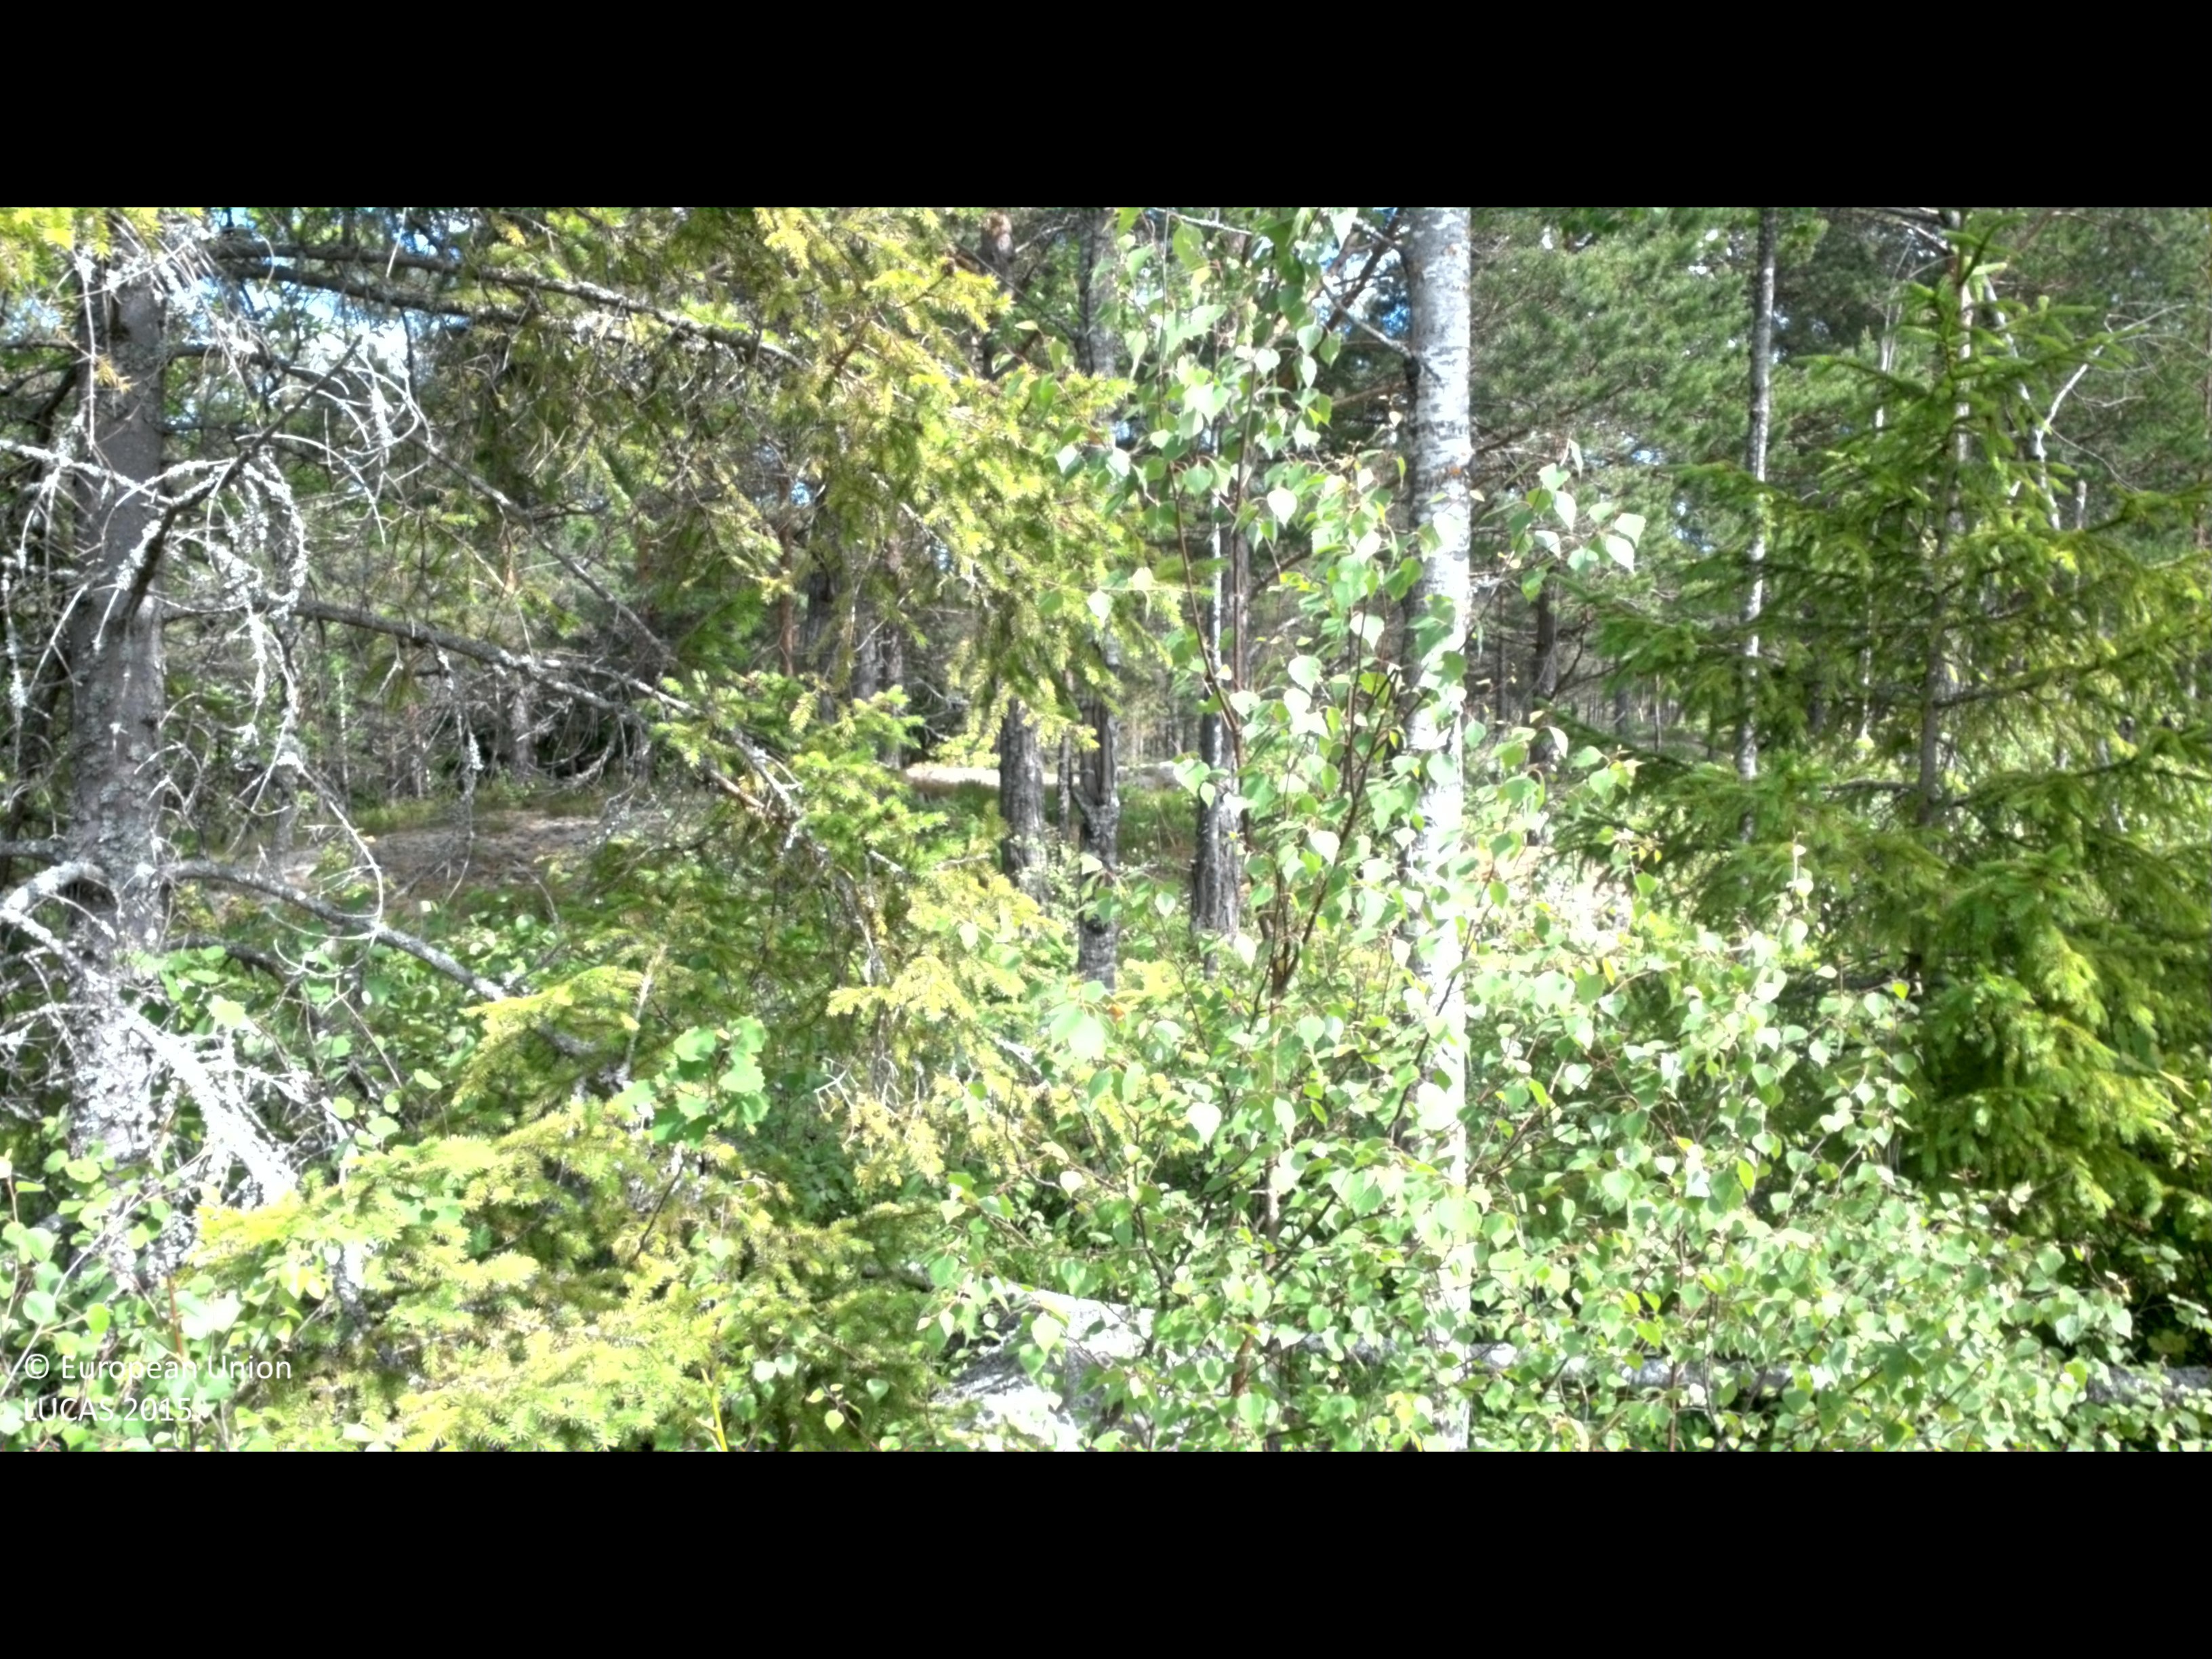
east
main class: Woodland
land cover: Other mixed woodland
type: boreal forest
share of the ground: 50 - 75 %
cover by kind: broadleaved forest trees 35 %, coniferous forest trees 30 %, shrubs 20 %, lichens and mosses 10 %, consolidated bare surface 5 %
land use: Forestry
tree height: > 5 m
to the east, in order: Other mixed woodland; Pine dominated coniferous woodland; Other mixed woodland; Spruce dominated coniferous woodland
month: June
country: SE
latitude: 57.7112
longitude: 16.6624
